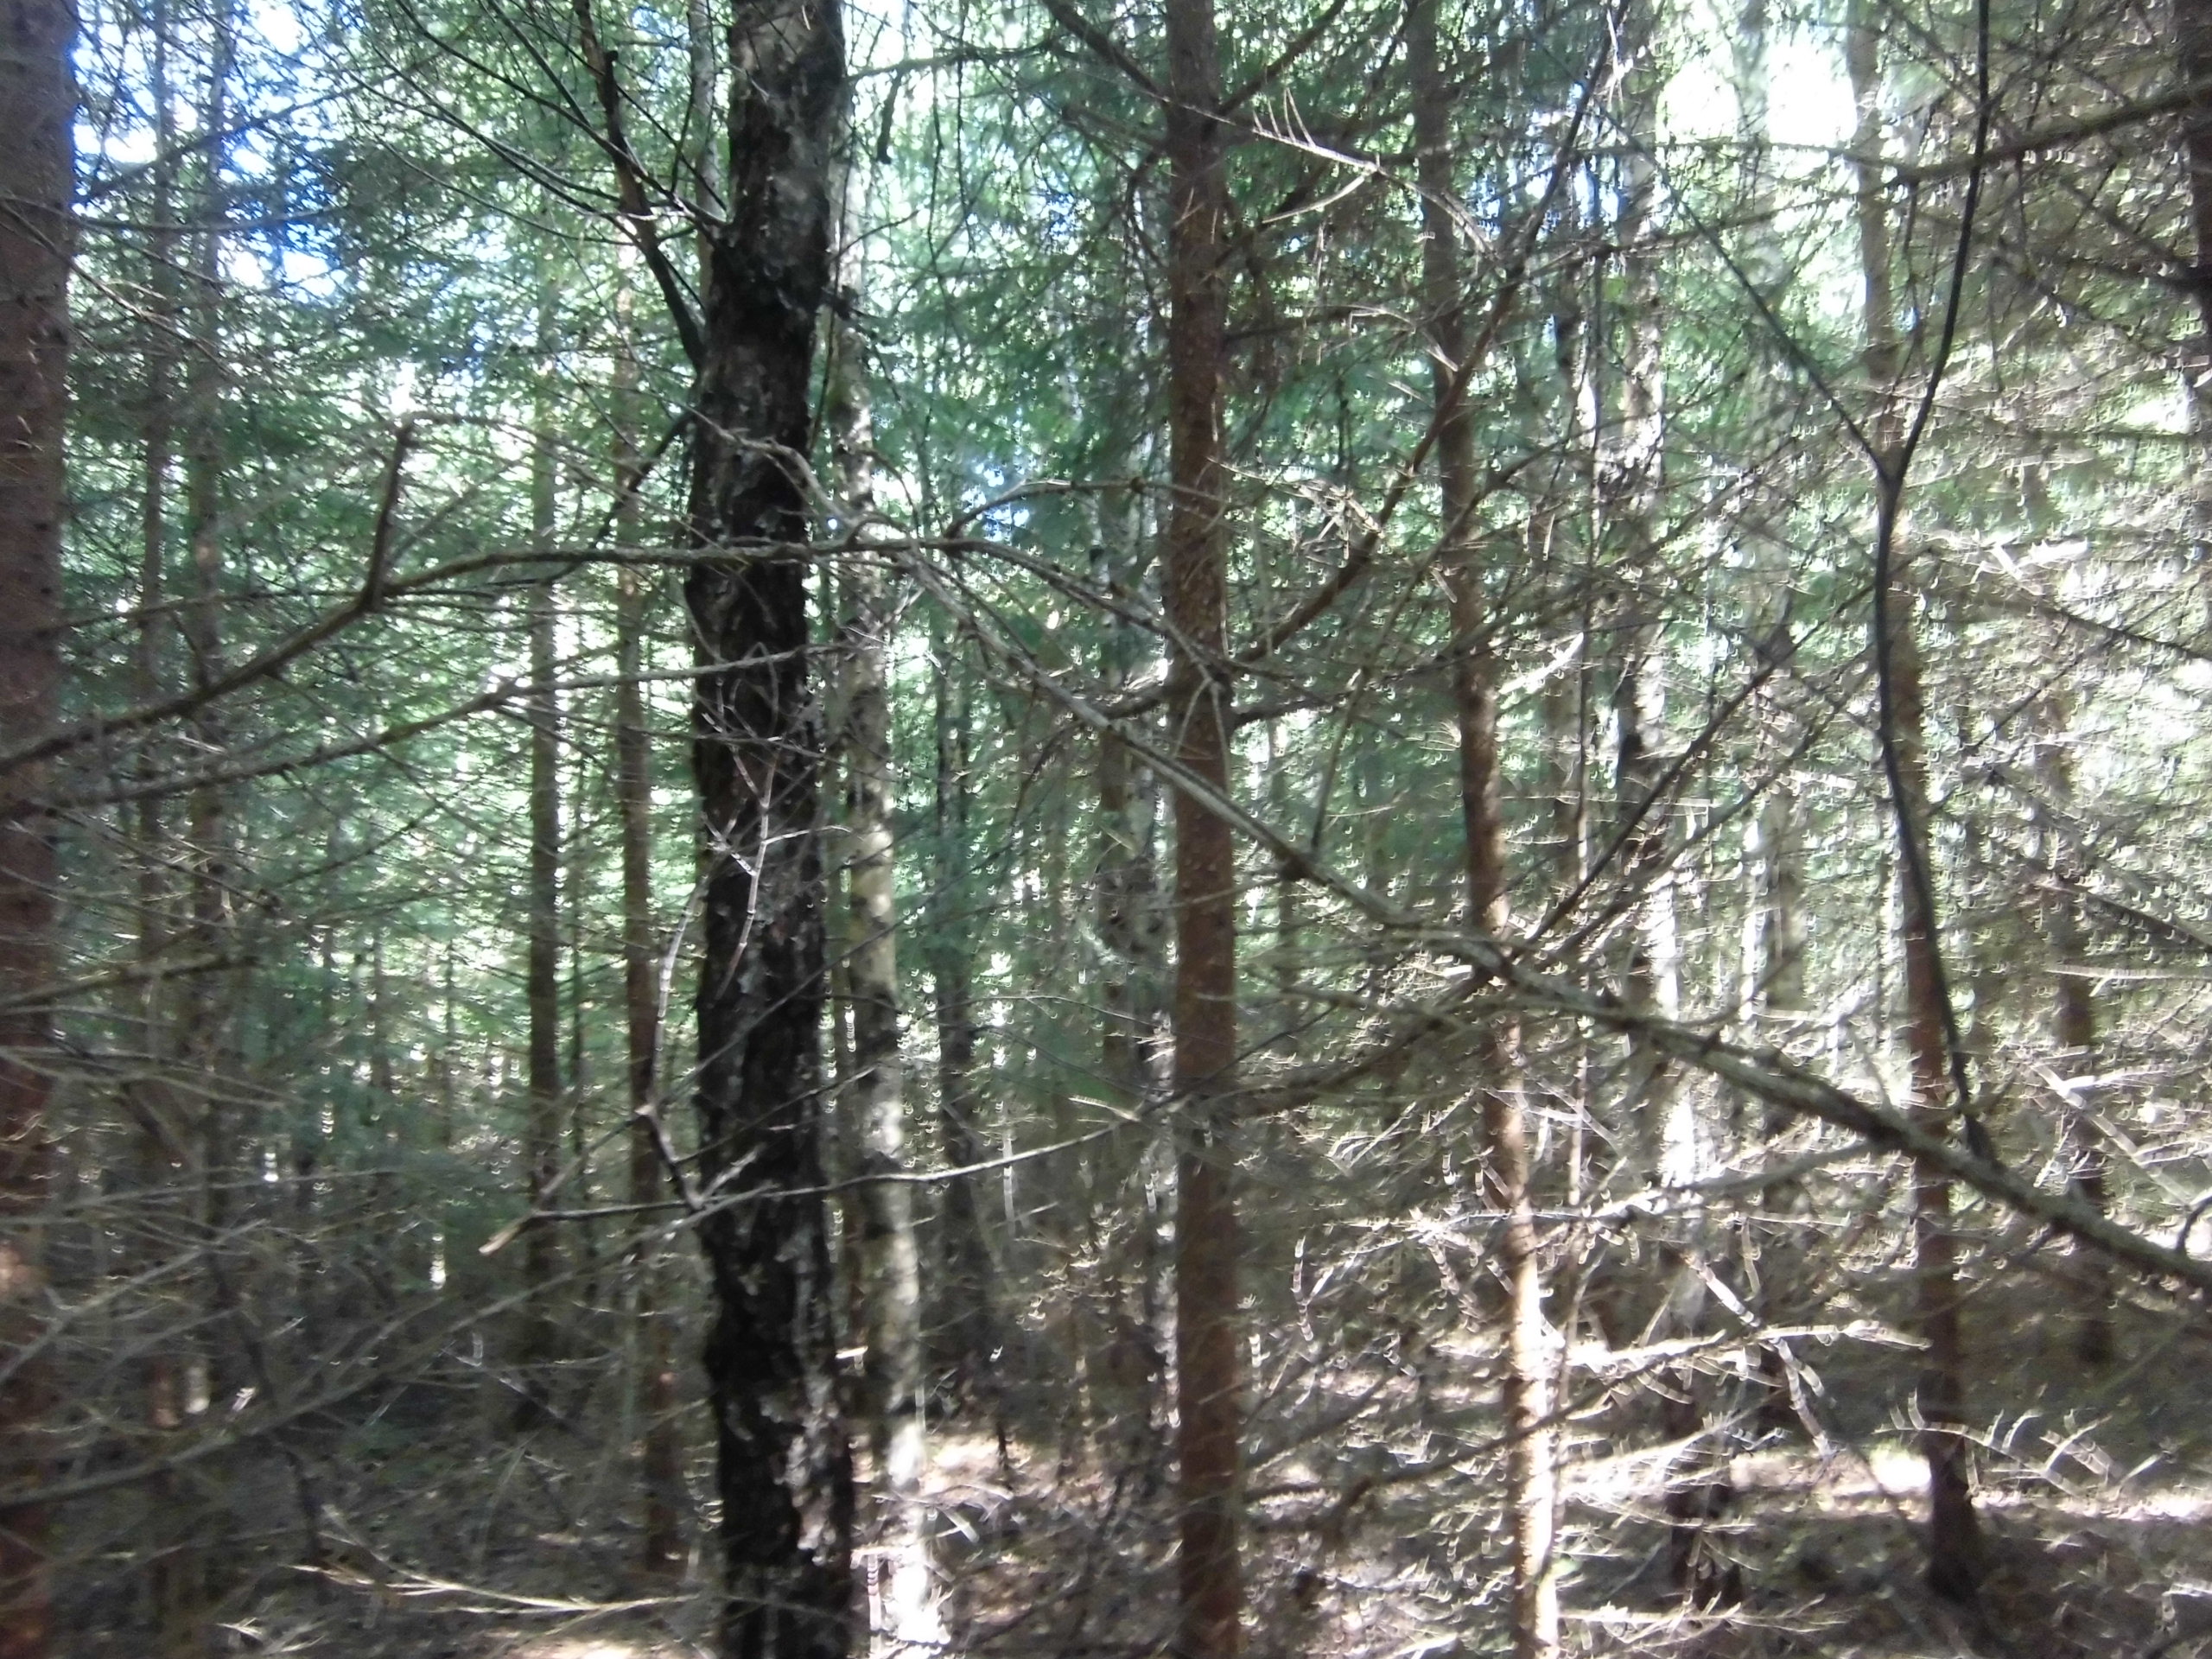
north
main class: Woodland
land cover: Spruce dominated coniferous woodland
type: boreal forest
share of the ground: > 75 %
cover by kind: coniferous forest trees 75 %, unconsolidated bare surface 15 %, broadleaved forest trees 5 %, lichens and mosses 5 %
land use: Forestry
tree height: > 5 m
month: July
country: SE
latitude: 57.3153
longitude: 15.4597
